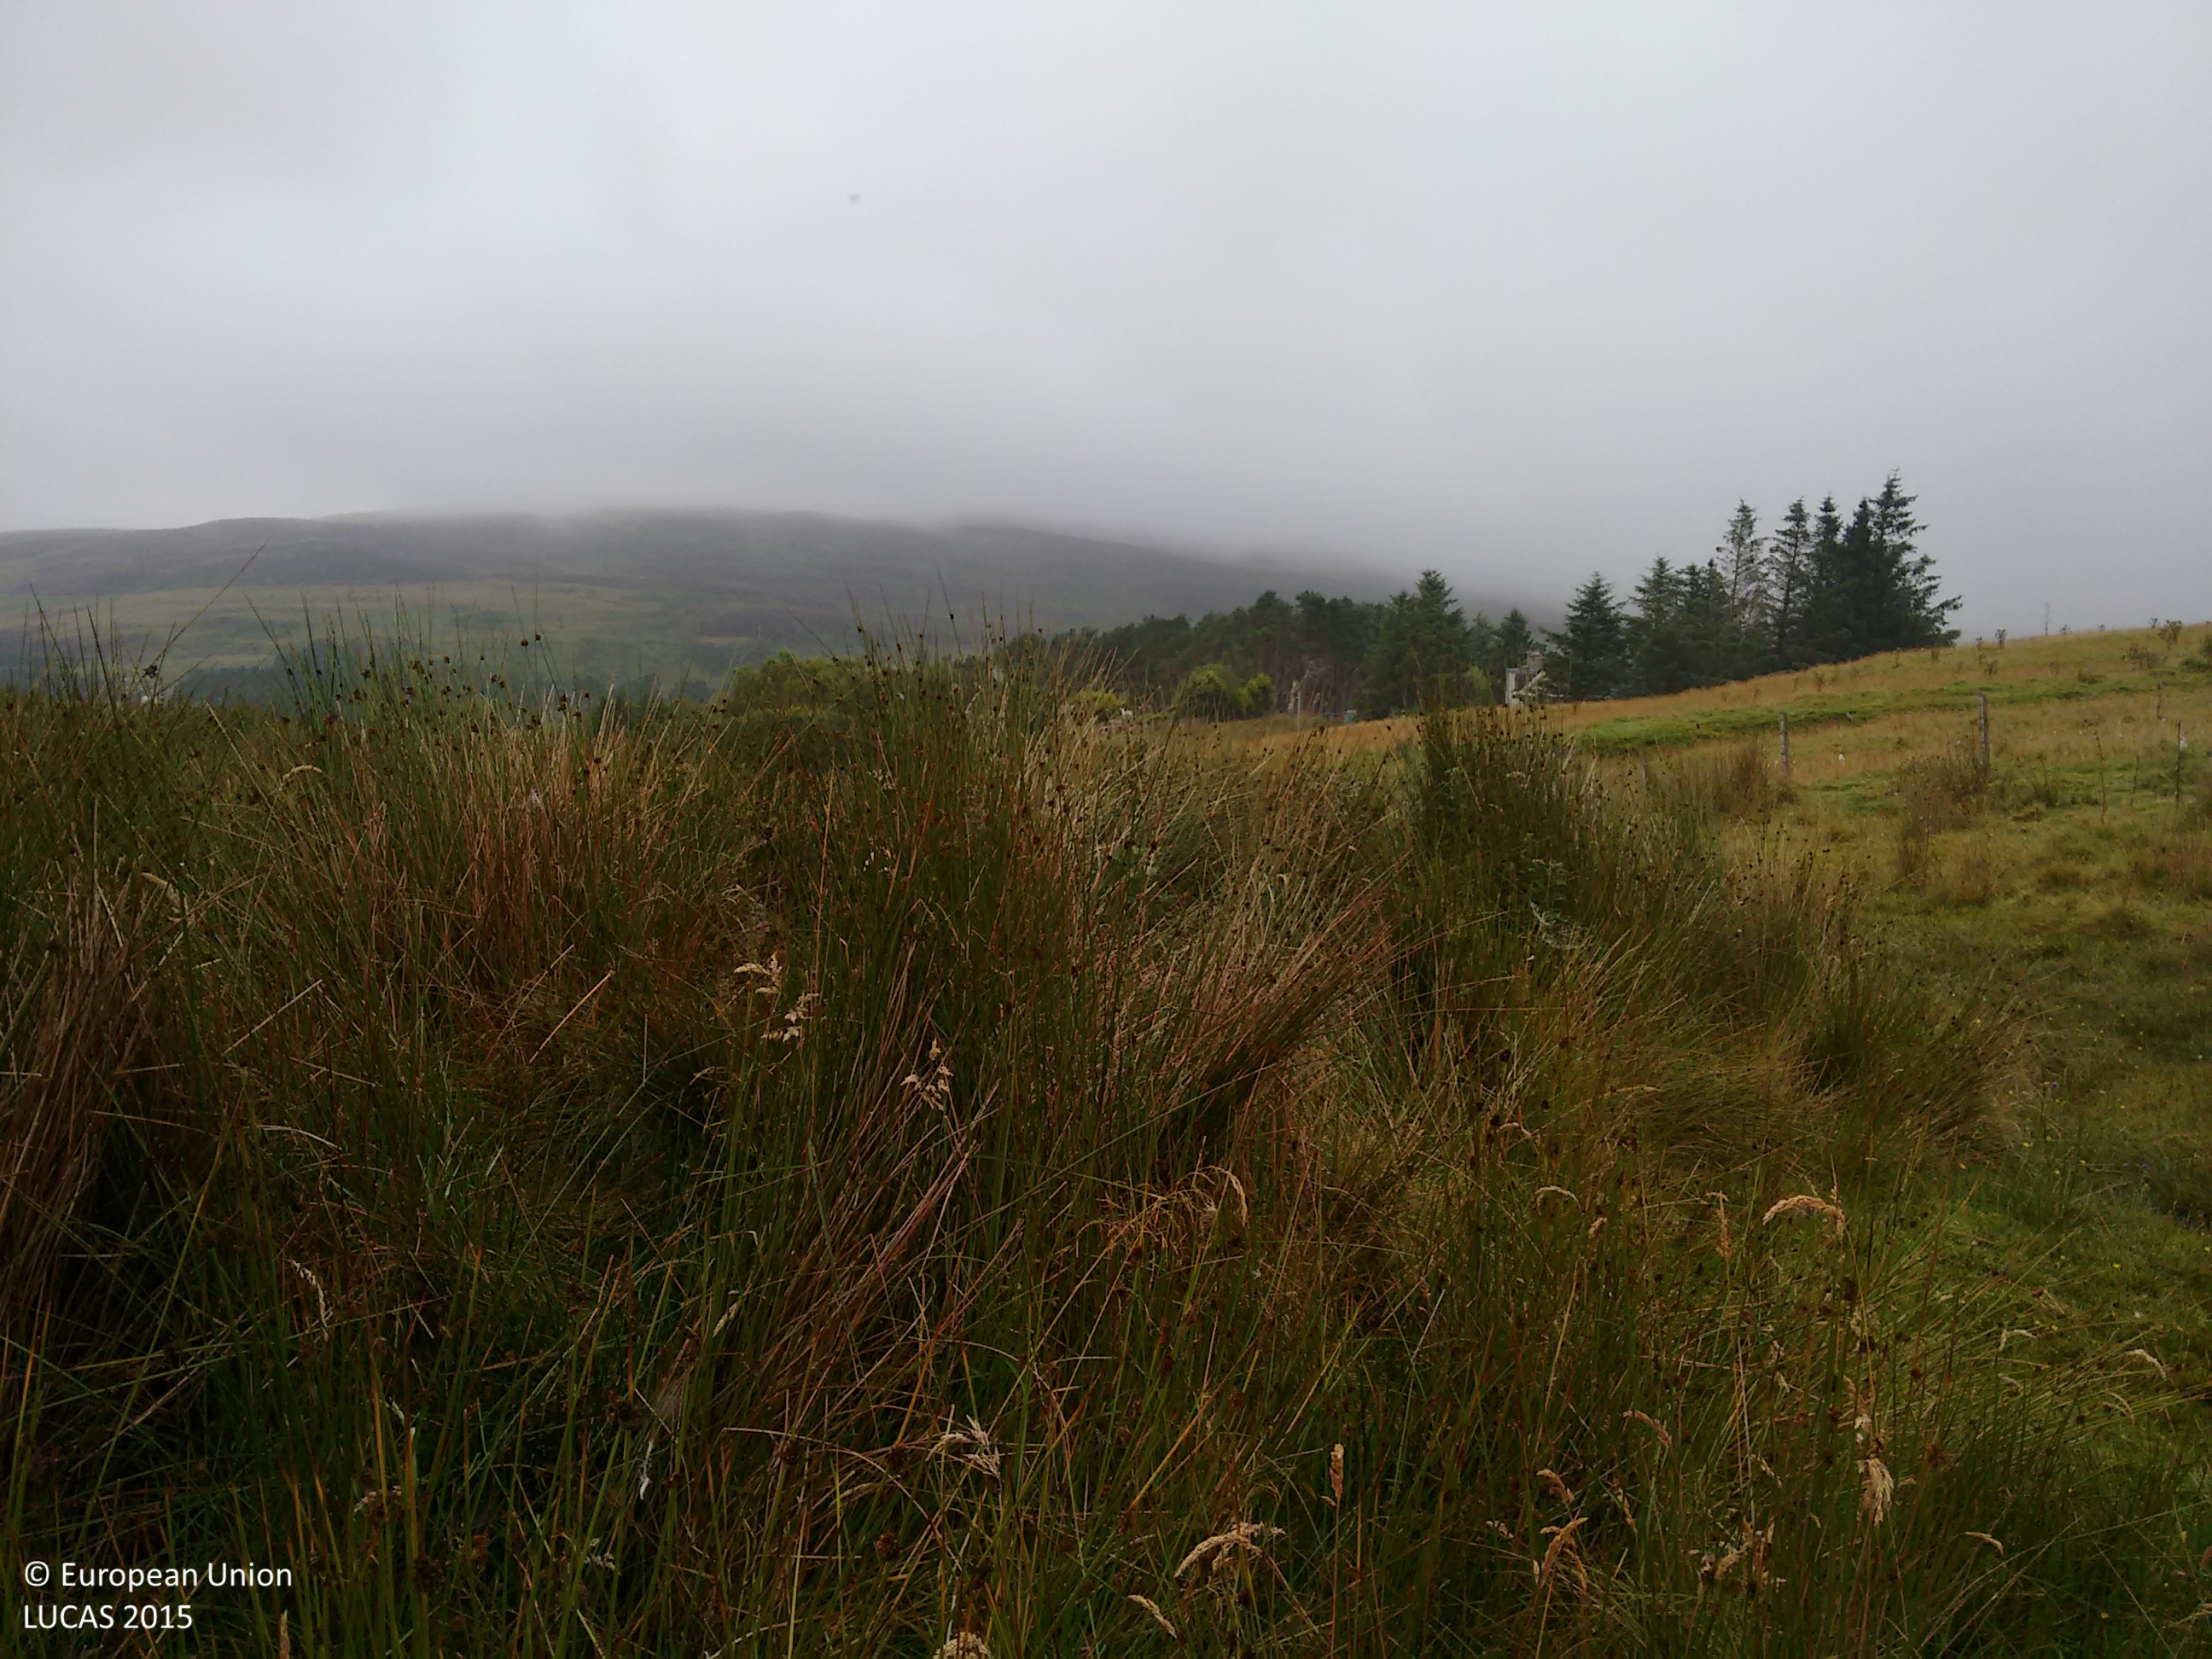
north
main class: Grassland
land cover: Grassland without tree/shrub cover
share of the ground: > 75 %
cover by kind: herbaceous plants 100 %
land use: Agriculture (excluding fallow land and kitchen gardens)
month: September
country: GB
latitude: 58.0113
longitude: -4.3523
